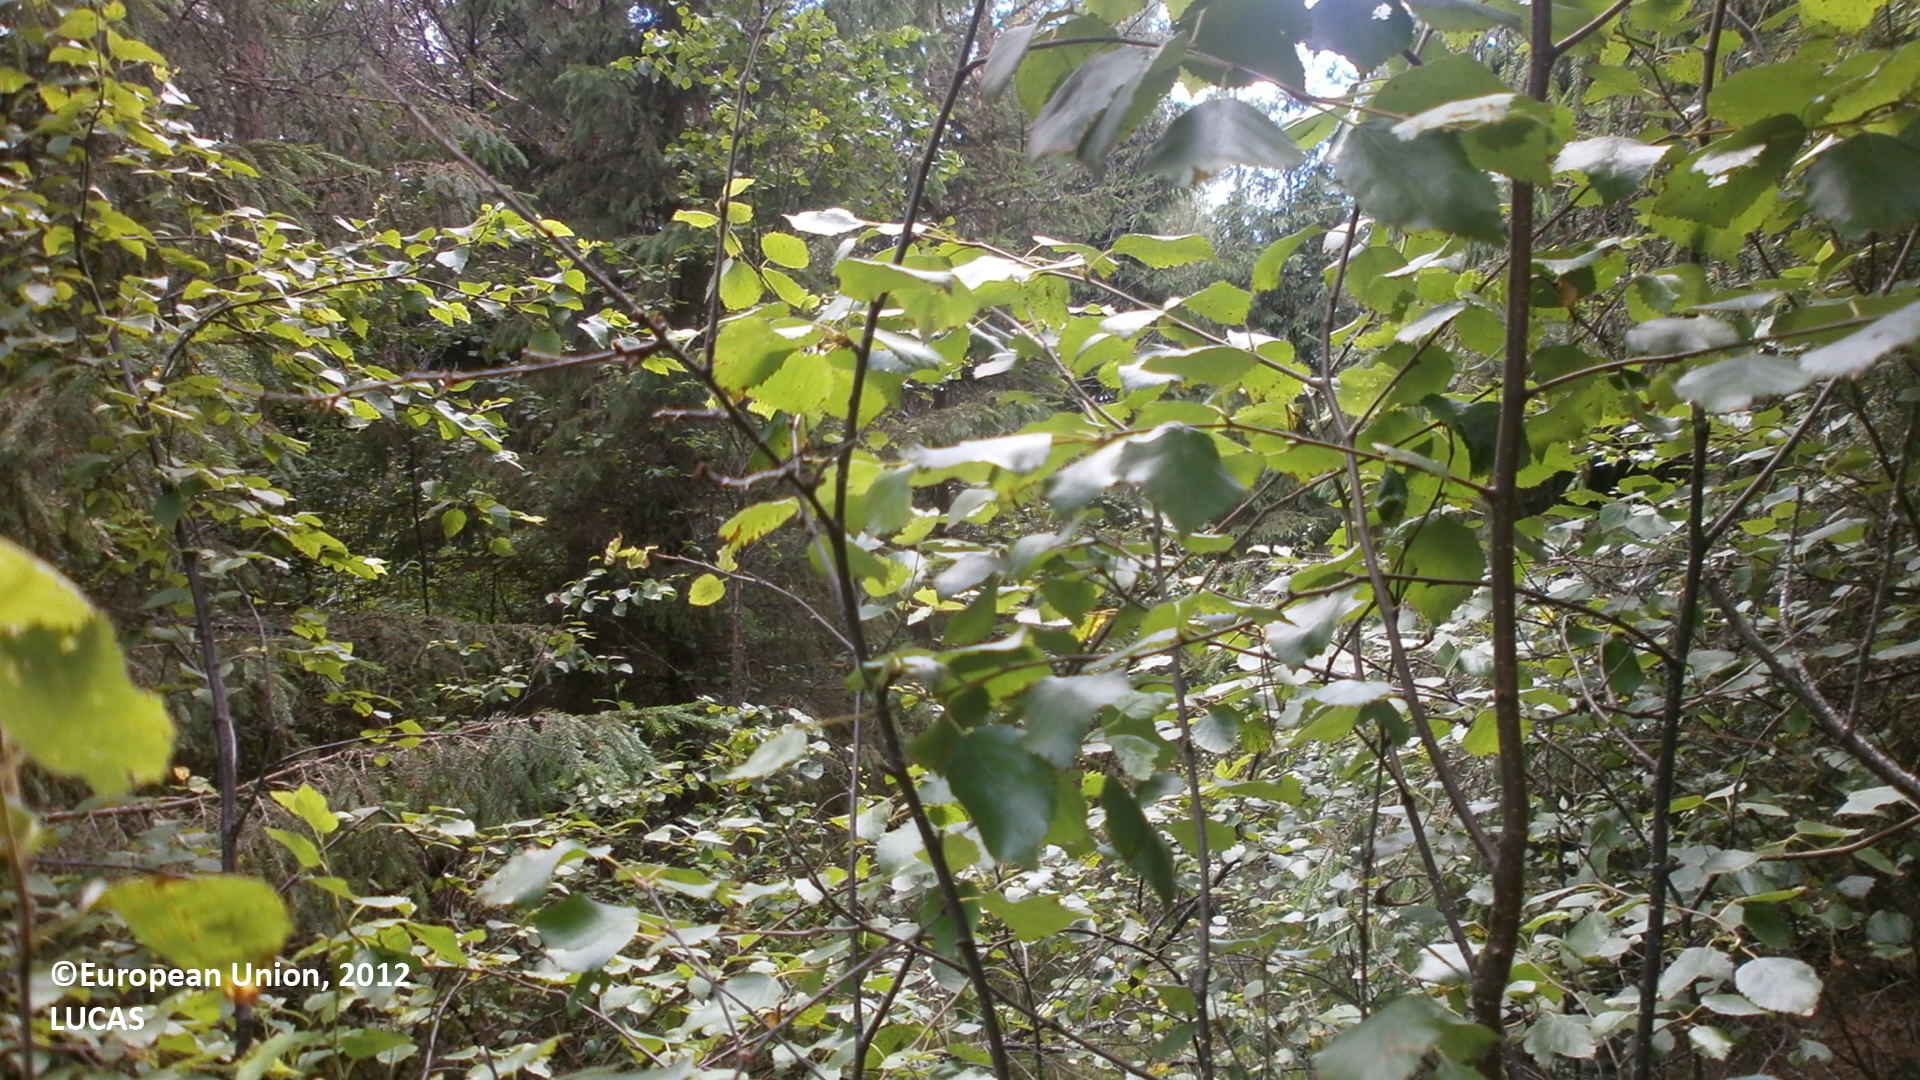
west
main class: Woodland
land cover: Other mixed woodland
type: boreal forest
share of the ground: 50 - 75 %
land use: Forestry
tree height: > 5 m
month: July
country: FI
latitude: 63.9956
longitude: 23.9866
